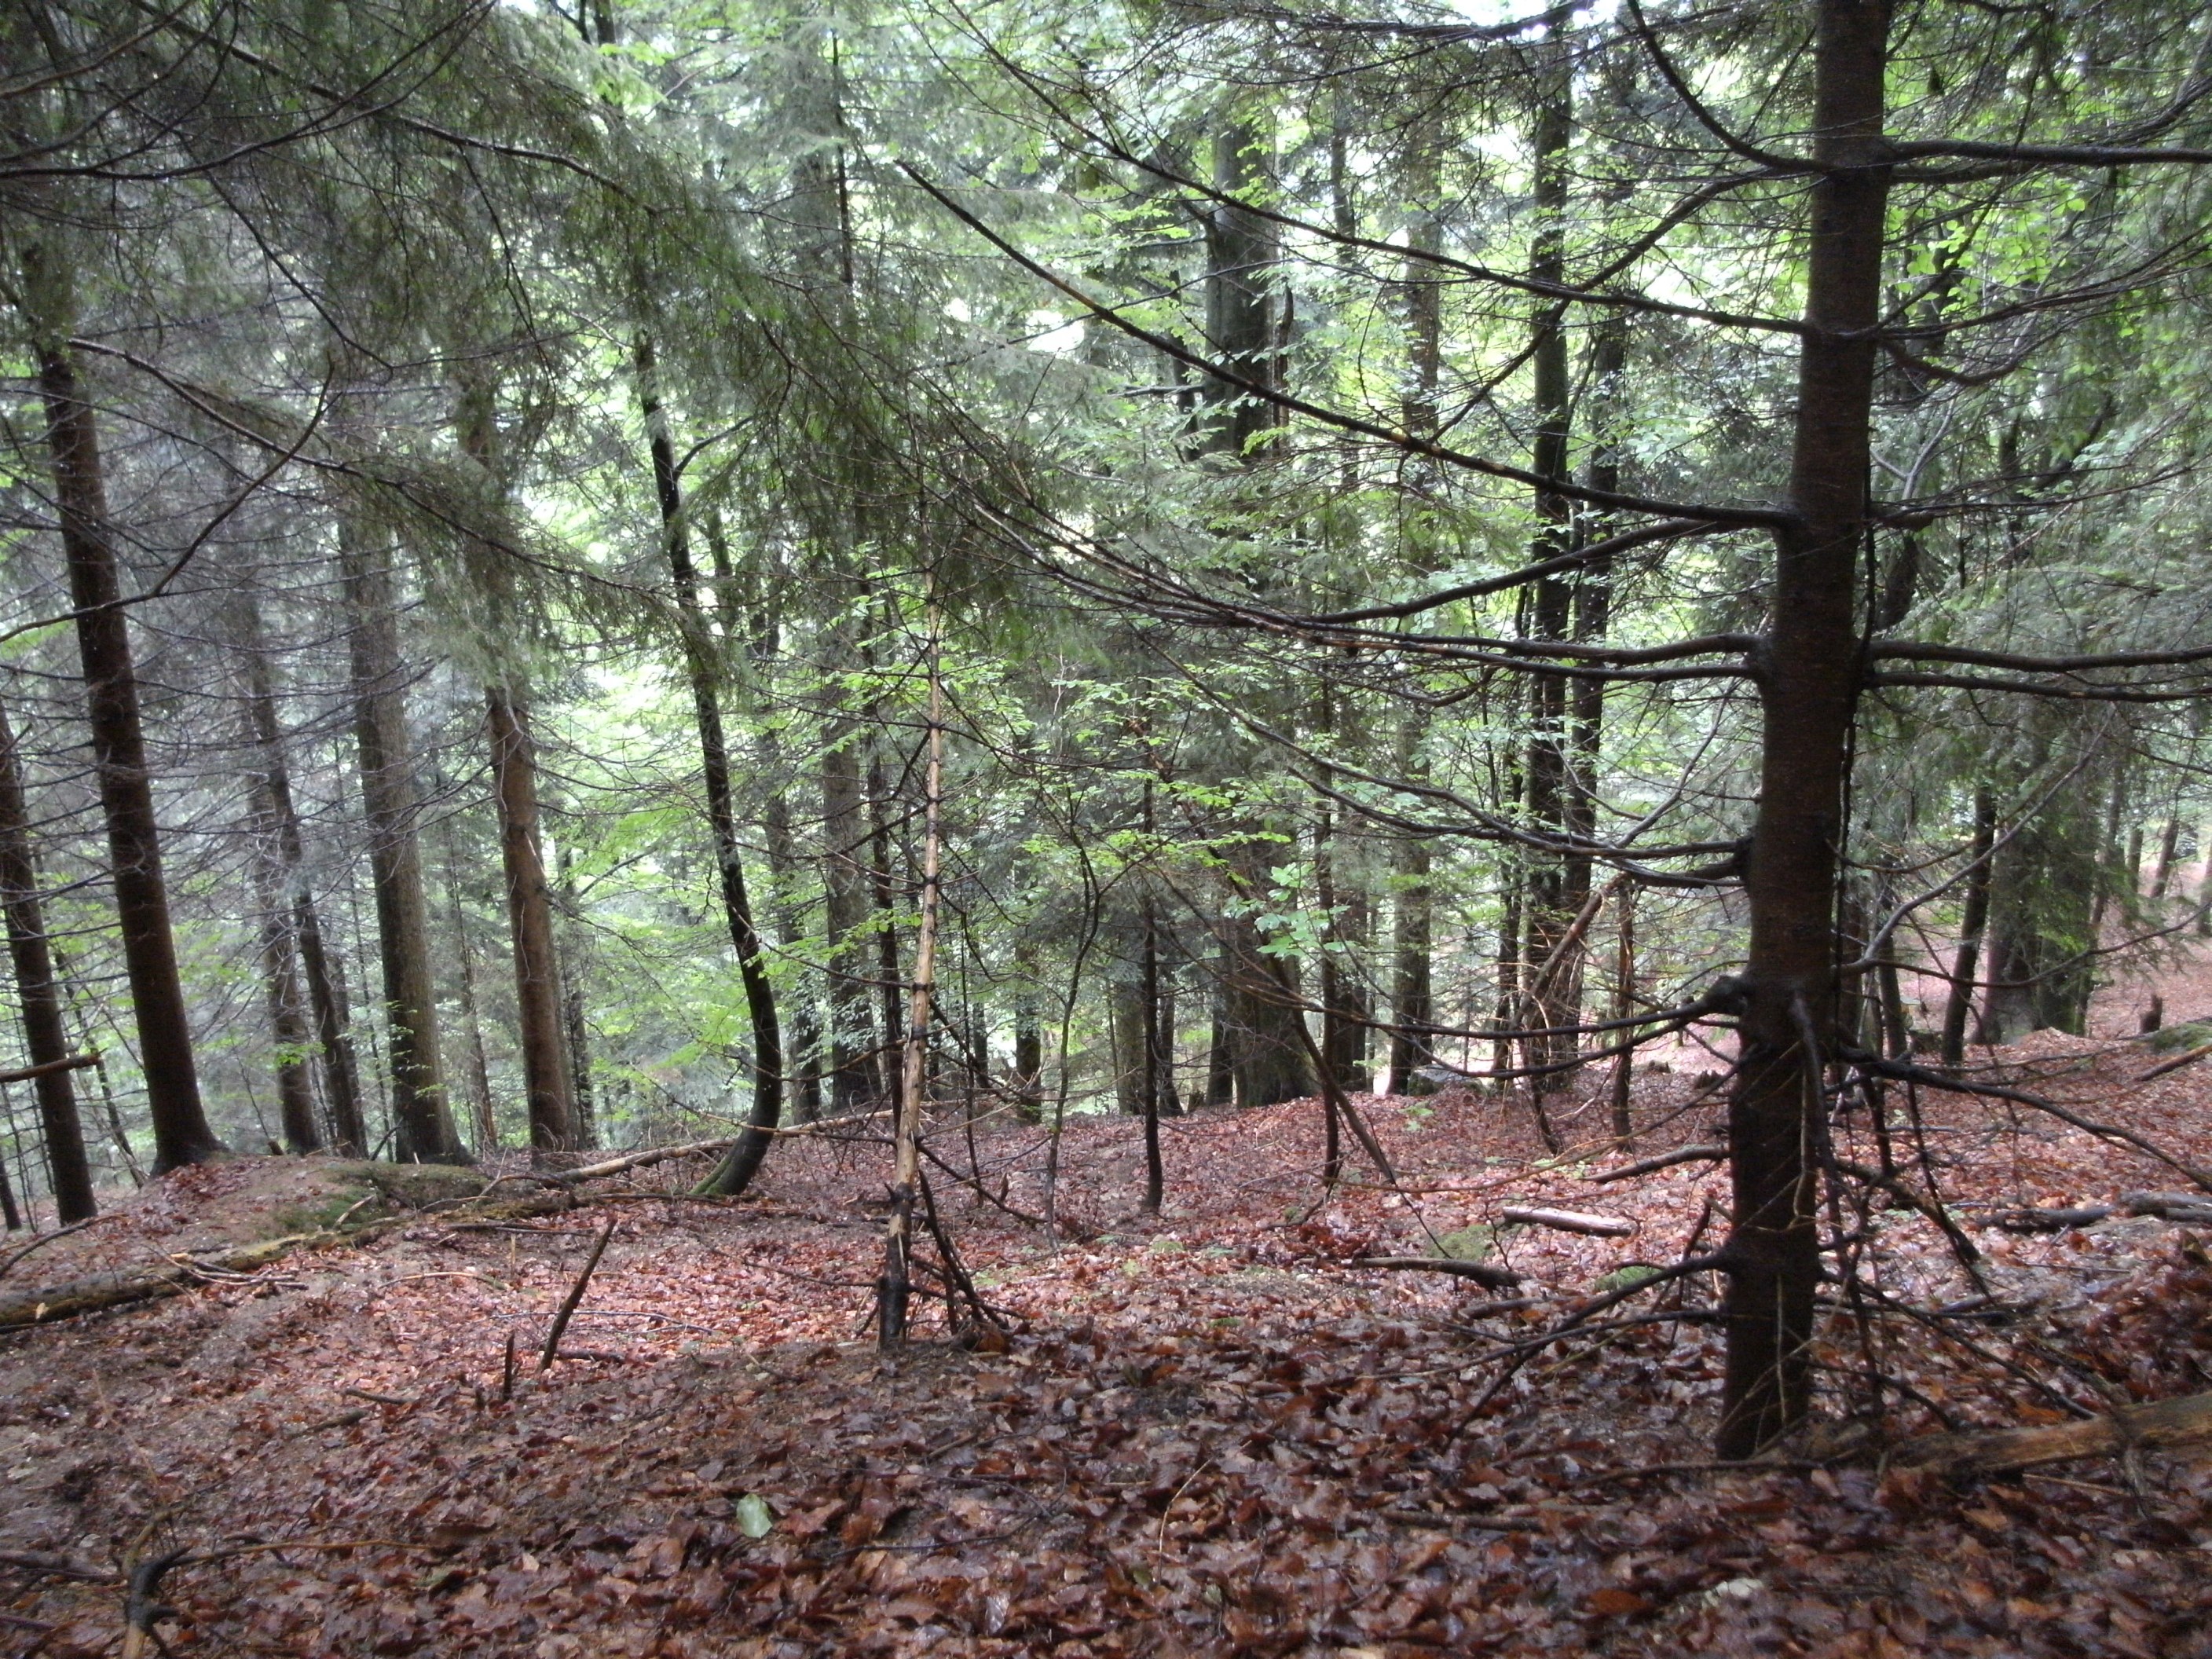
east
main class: Woodland
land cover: Spruce dominated mixed woodland
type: beech forest
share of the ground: > 75 %
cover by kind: coniferous forest trees 50 %, broadleaved forest trees 50 %
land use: Forestry
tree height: > 5 m
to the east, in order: Spruce dominated mixed woodland; Other mixed woodland; Tracks; Other mixed woodland; Spruce dominated coniferous woodland; Spruce dominated mixed woodland; Ditches and canals; Grassland without tree/shrub cover; Rivers and streams; Spruce dominated coniferous woodland; Rivers and streams; Spruce dominated mixed woodland
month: June
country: AT
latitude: 48.5882
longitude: 13.8638
